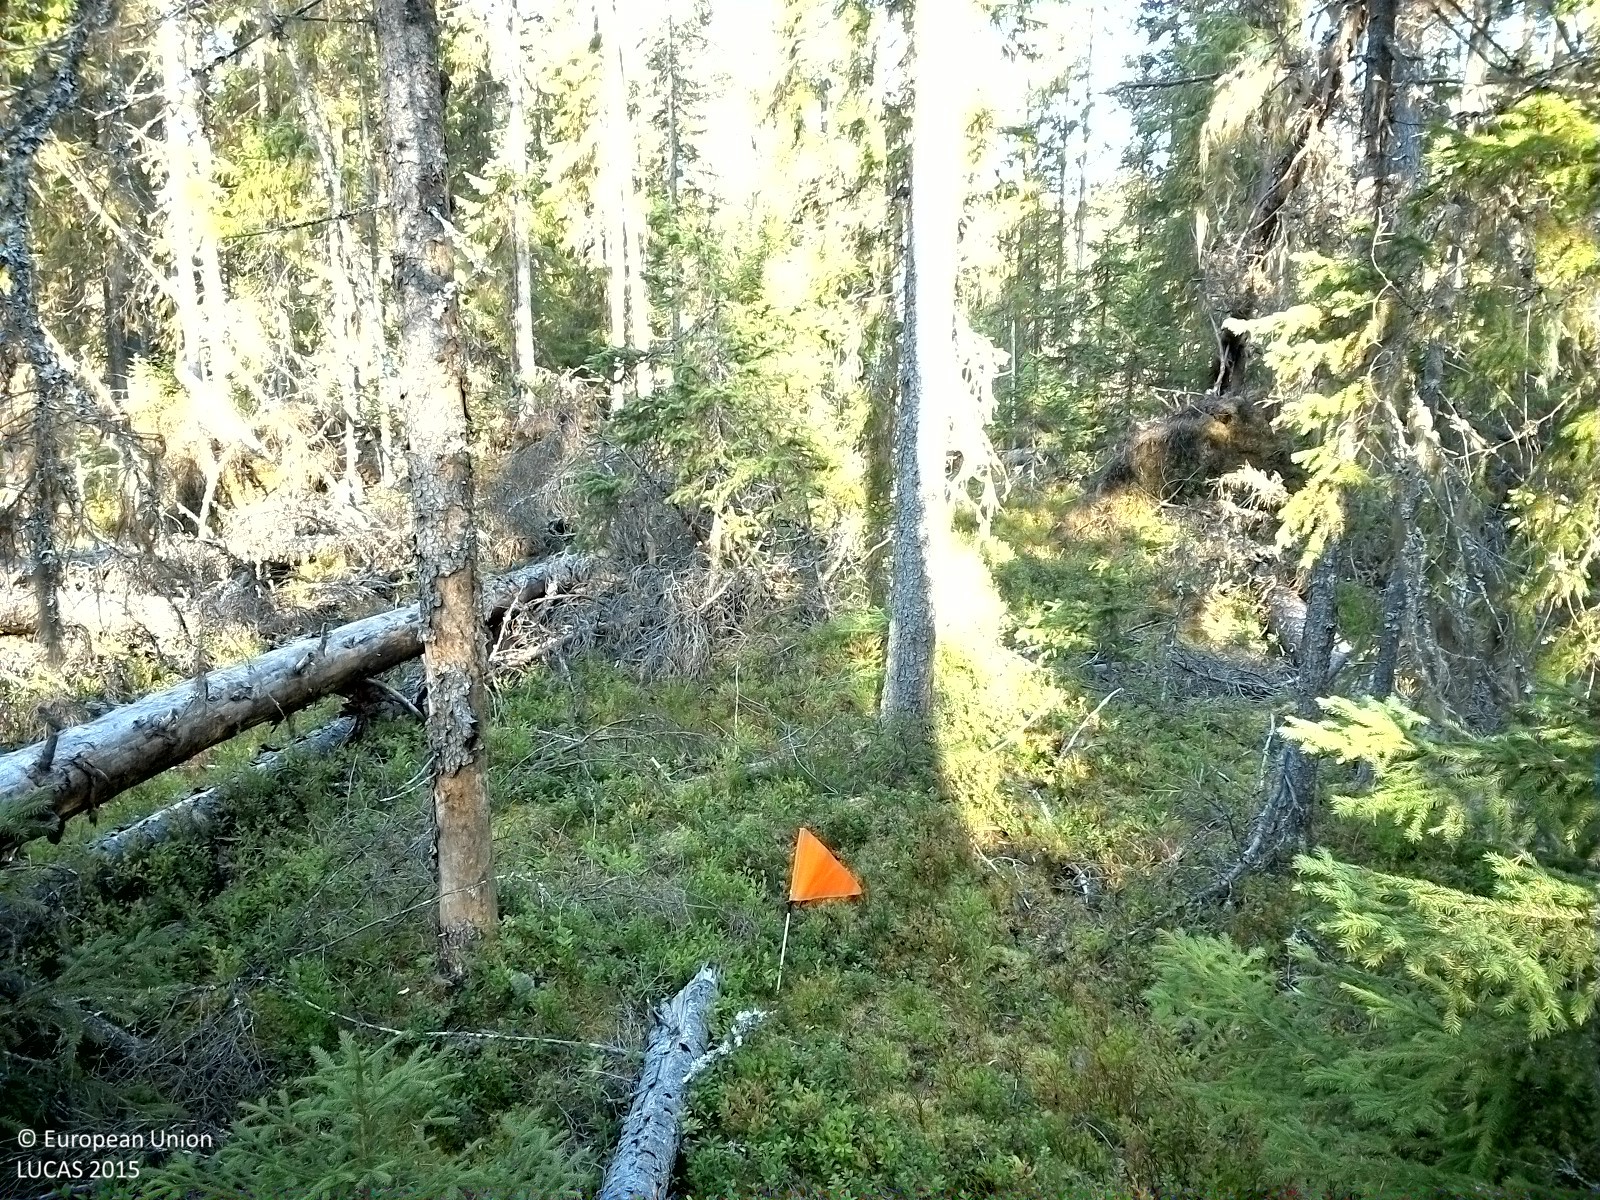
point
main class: Woodland
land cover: Pine dominated coniferous woodland
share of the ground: 25 - 50 %
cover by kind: coniferous forest trees 50 %, lichens and mosses 30 %, shrubs 20 %
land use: Forestry
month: September
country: SE
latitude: 62.5983
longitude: 16.0750
